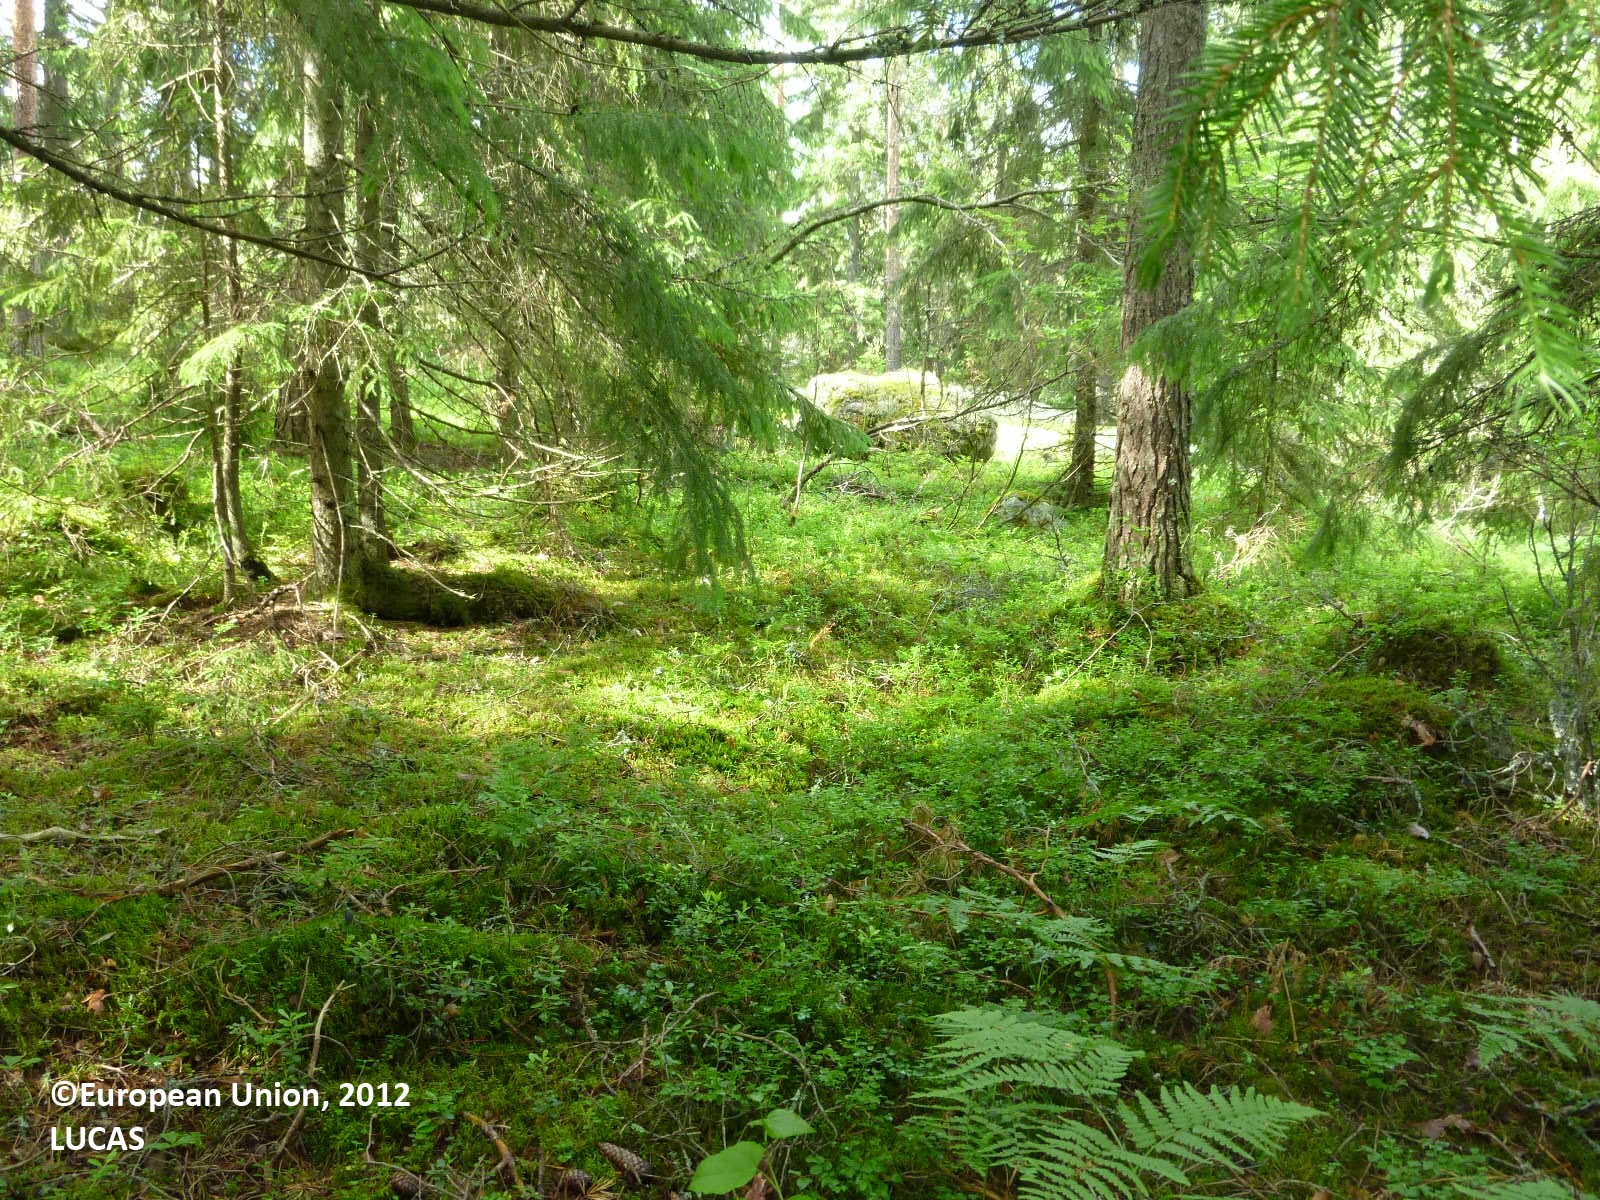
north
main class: Woodland
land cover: Spruce dominated coniferous woodland
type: boreal forest
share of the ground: 50 - 75 %
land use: Forestry
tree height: > 5 m
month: June
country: FI
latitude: 60.2671
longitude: 22.6366
